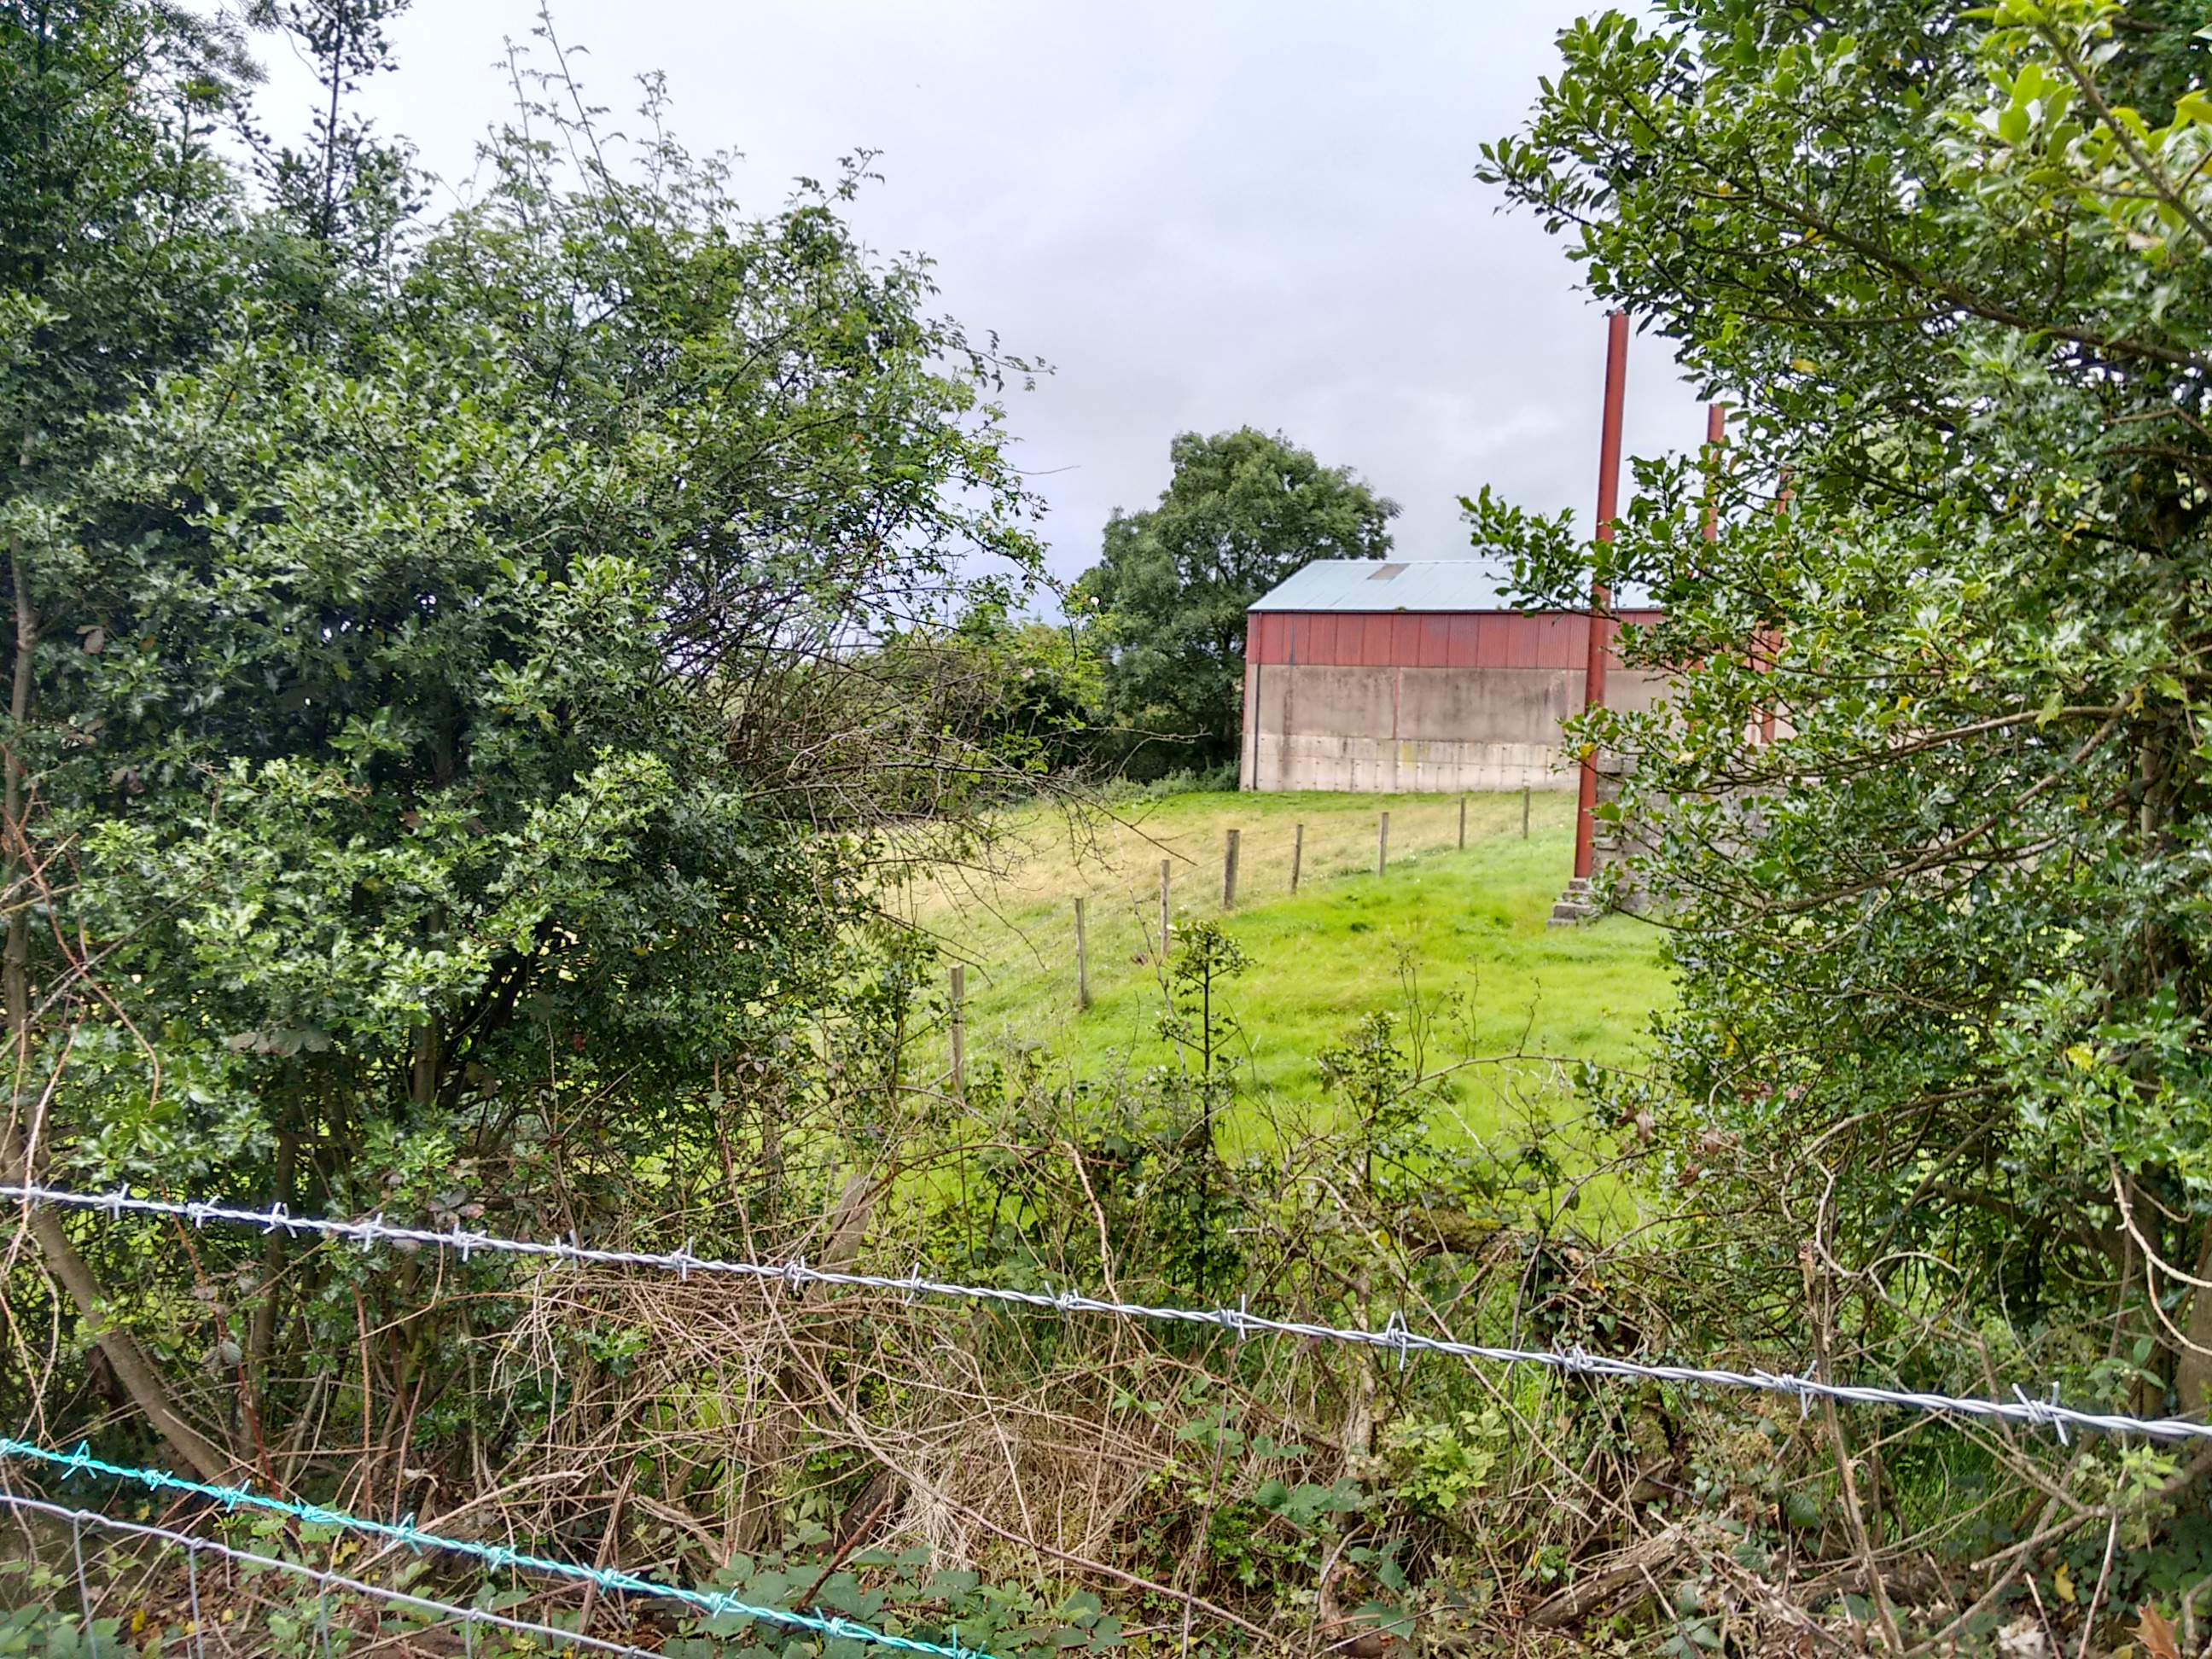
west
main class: Grassland
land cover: Grassland without tree/shrub cover
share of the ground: > 75 %
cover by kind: herbaceous plants 100 %
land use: Agriculture (excluding fallow land and kitchen gardens)
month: August
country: GB
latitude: 54.5982
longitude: -6.8675
